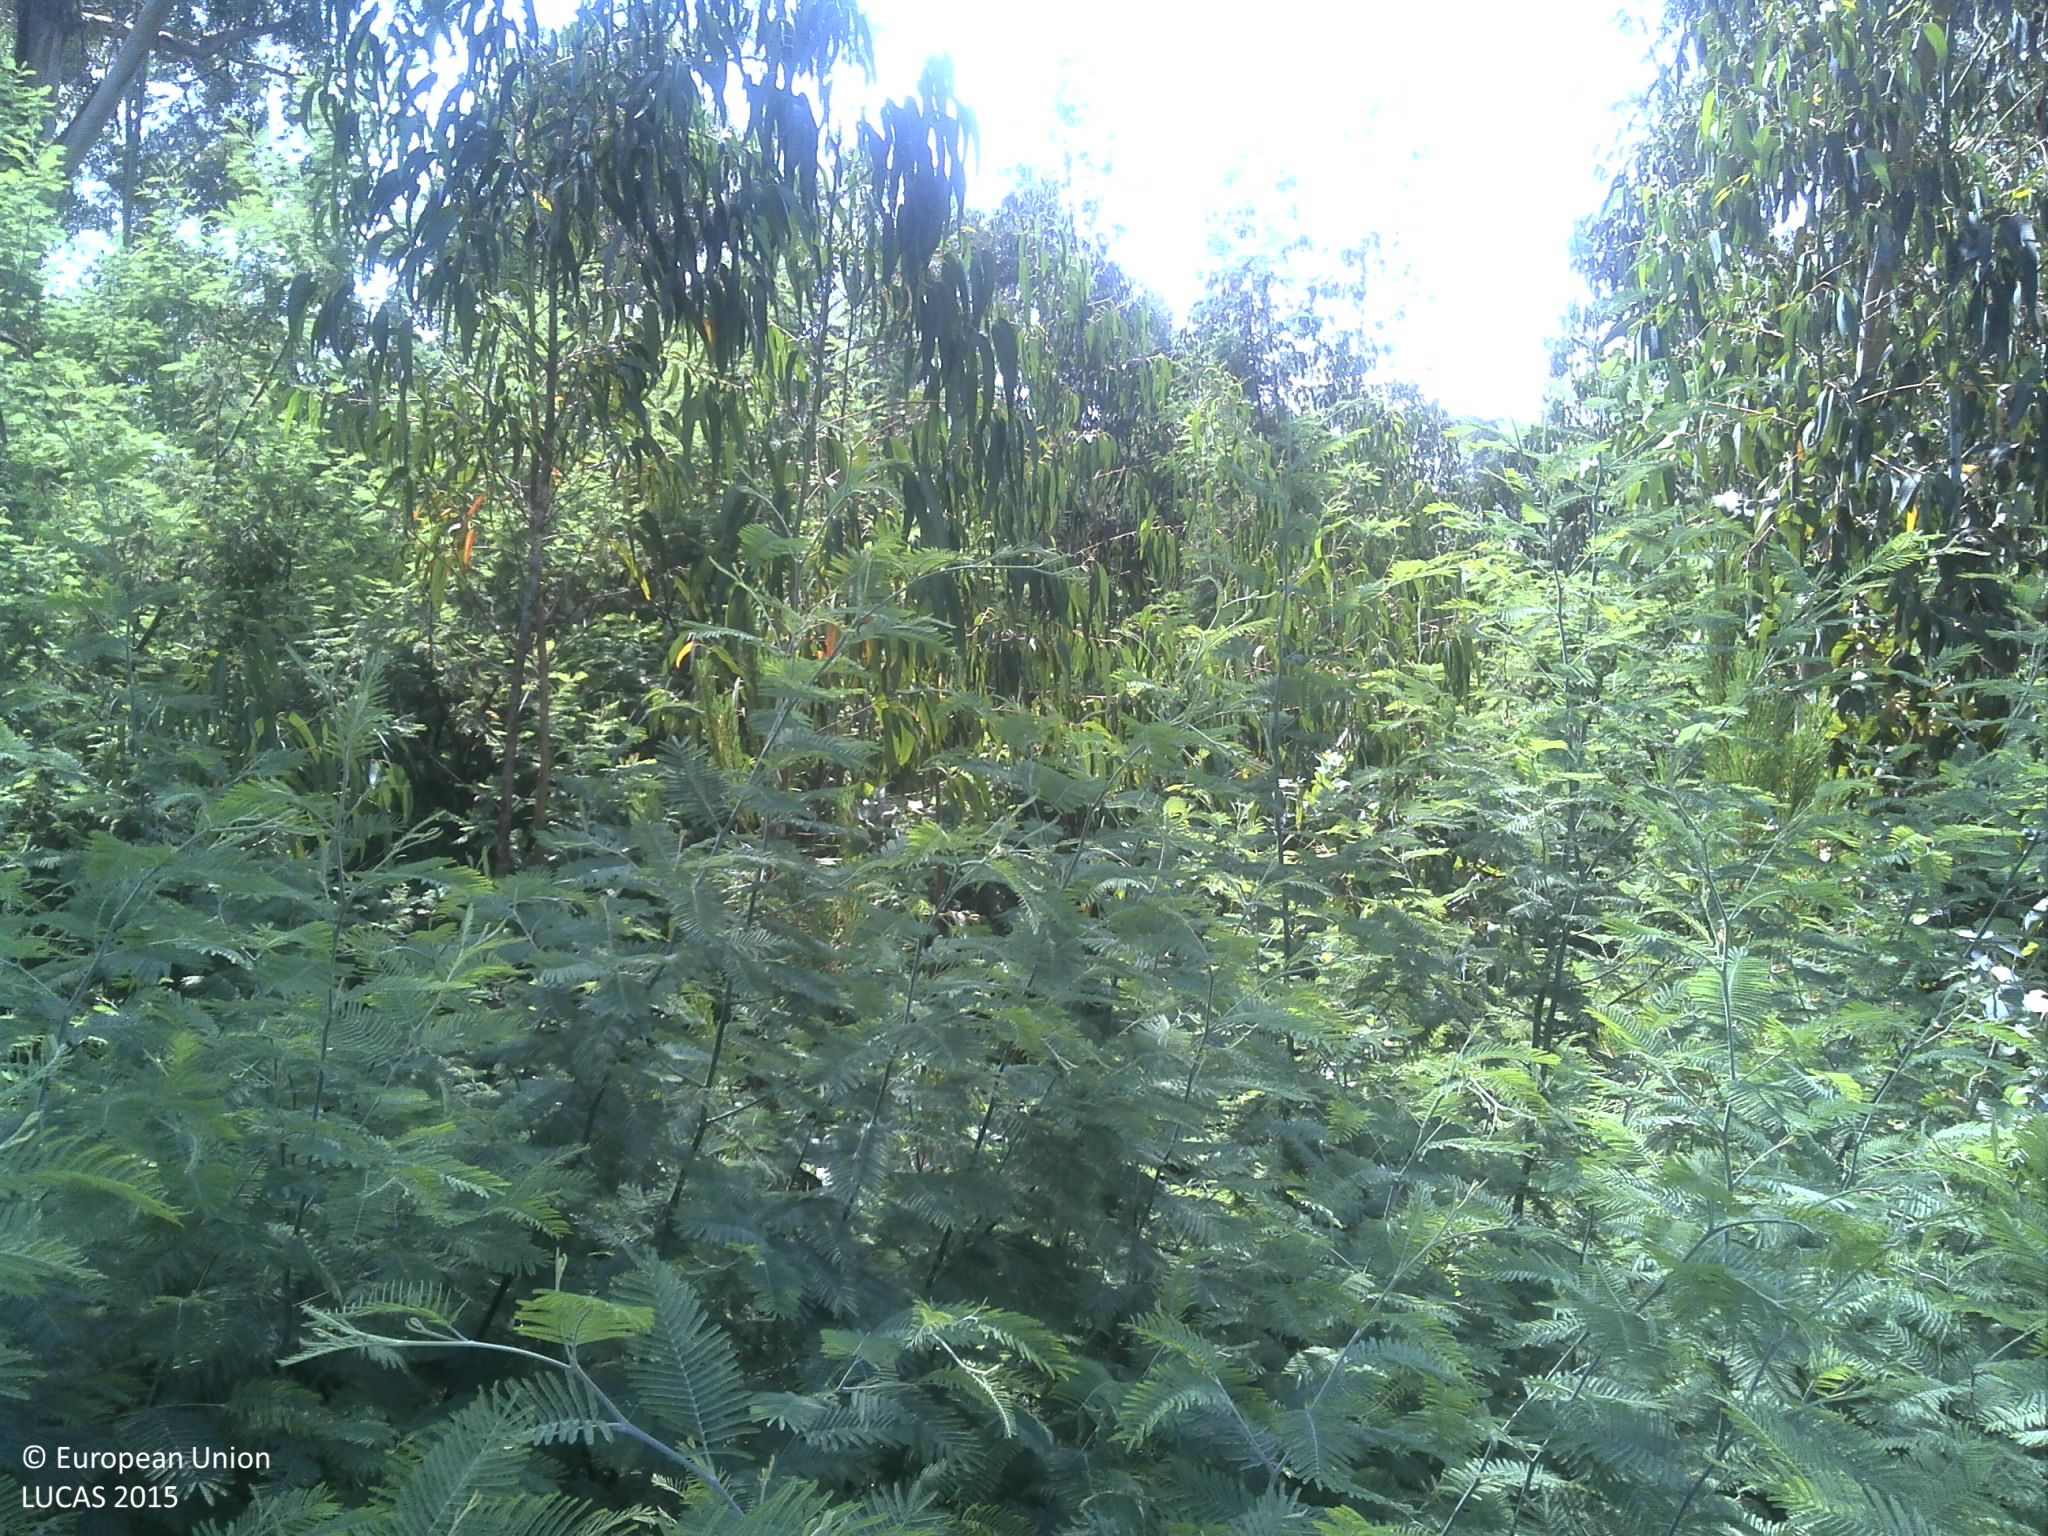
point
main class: Woodland
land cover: Broadleaved woodland
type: exotic forest
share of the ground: > 75 %
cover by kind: broadleaved forest trees 85 %, shrubs 10 %, unconsolidated bare surface 5 %
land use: Forestry
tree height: > 5 m
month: June
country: PT
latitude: 41.1252
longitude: -8.1605
